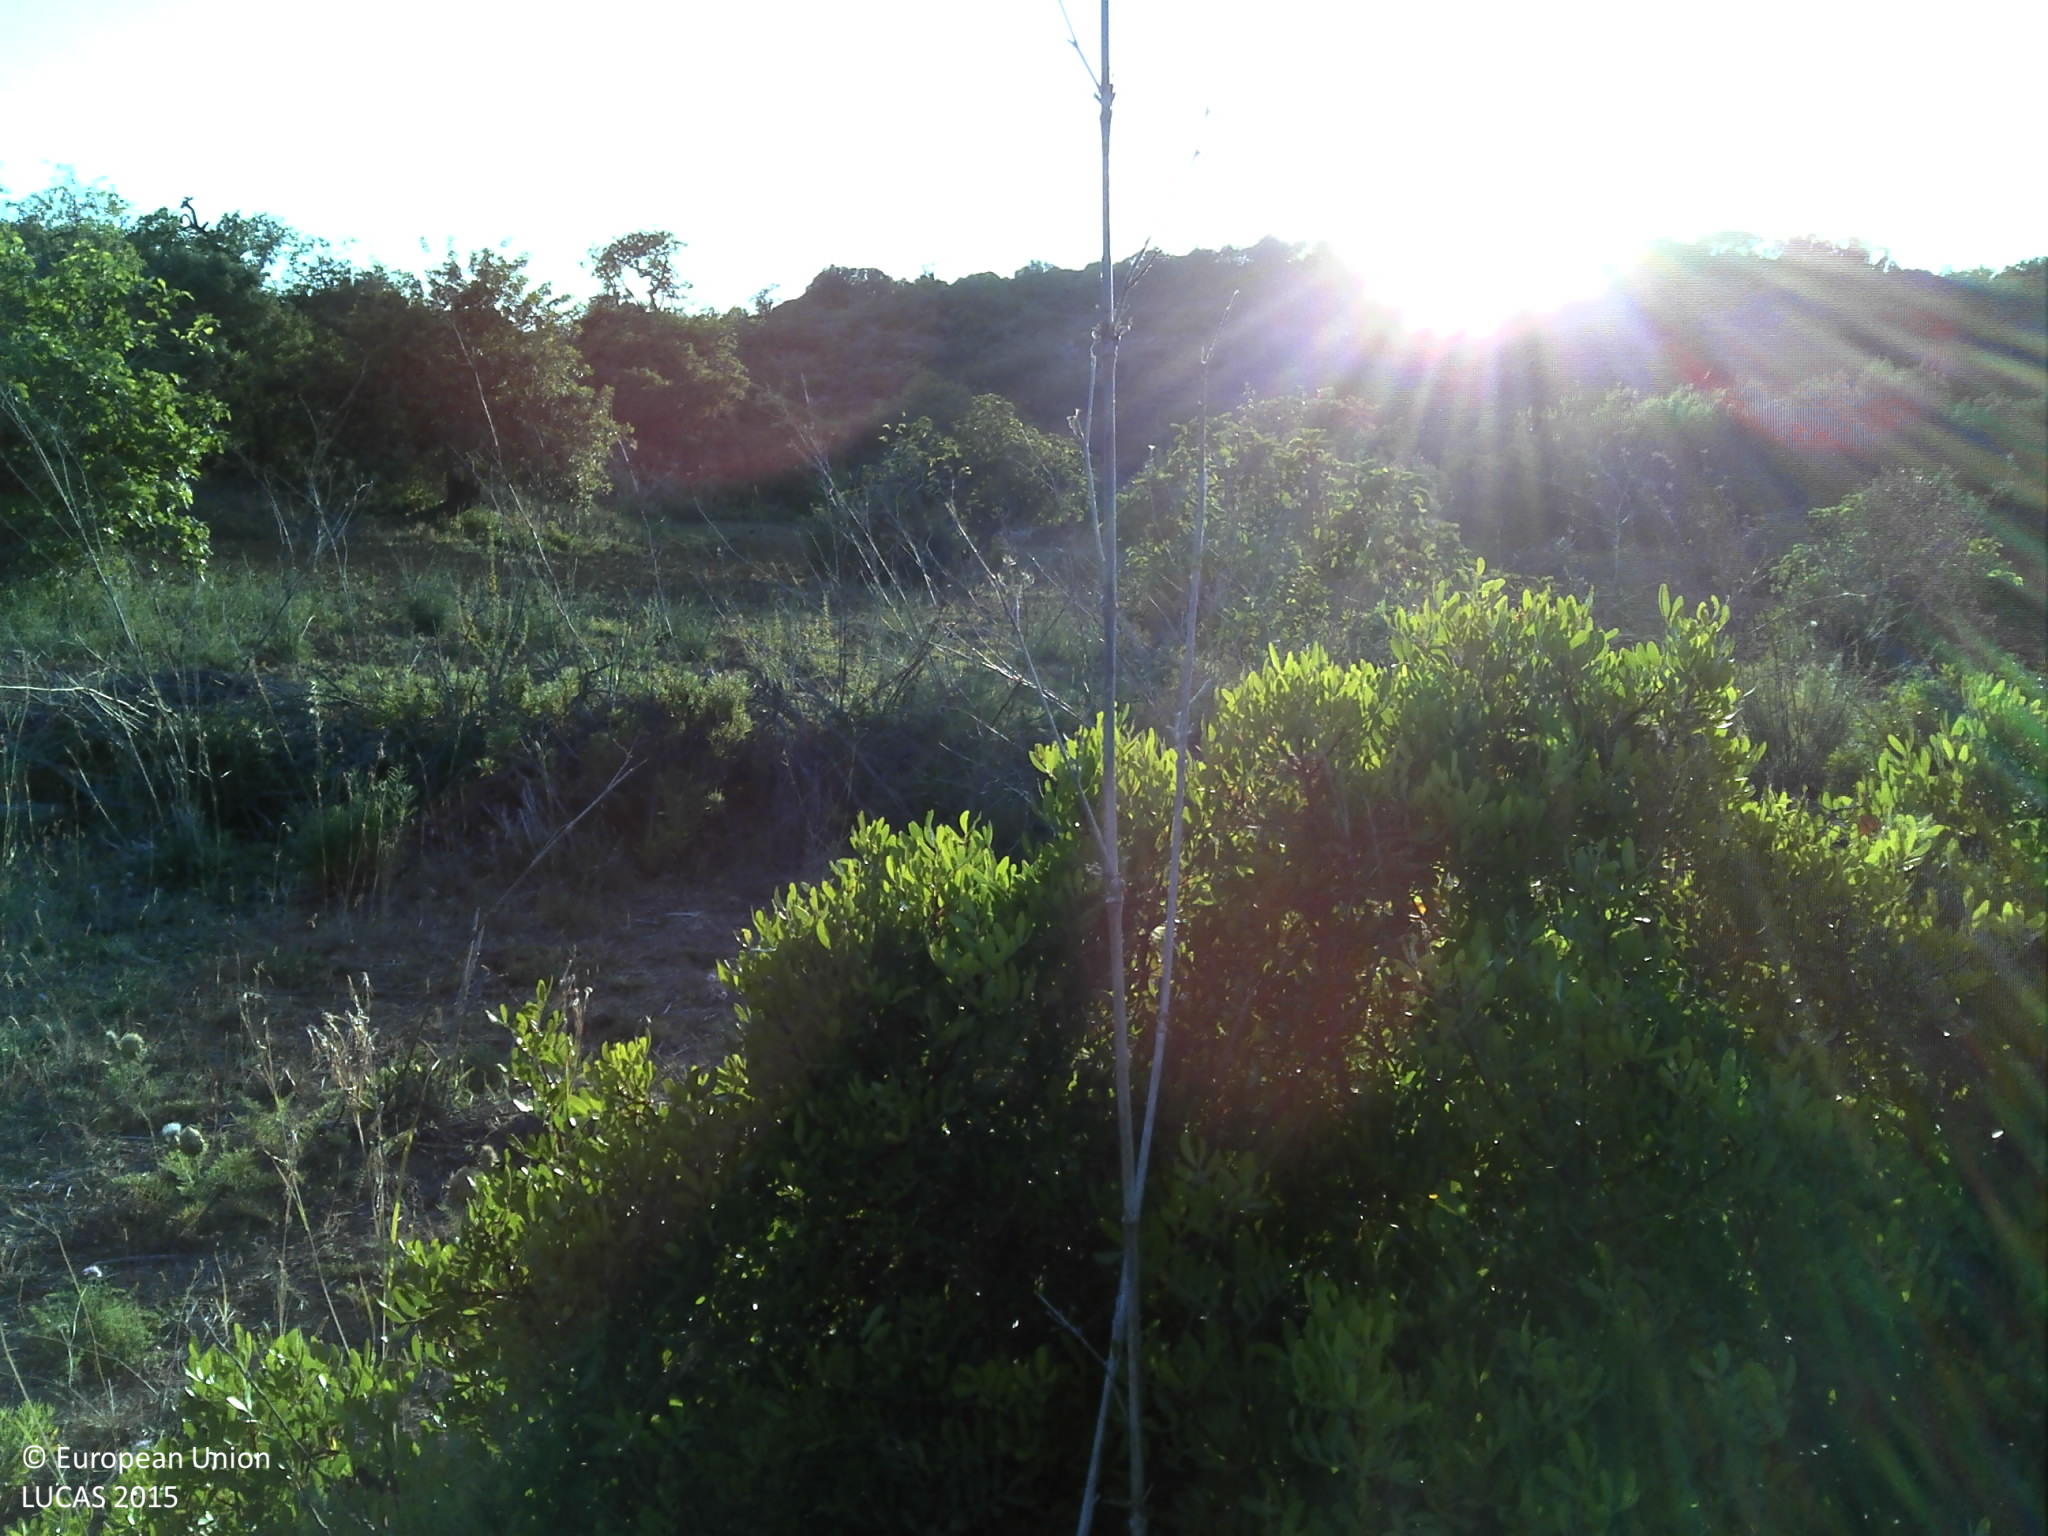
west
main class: Shrubland
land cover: Shrubland without tree cover
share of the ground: 25 - 50 %
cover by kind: shrubs 55 %, herbaceous plants 45 %
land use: Semi-natural and natural areas not in use
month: June
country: PT
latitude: 37.0518
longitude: -7.8068
